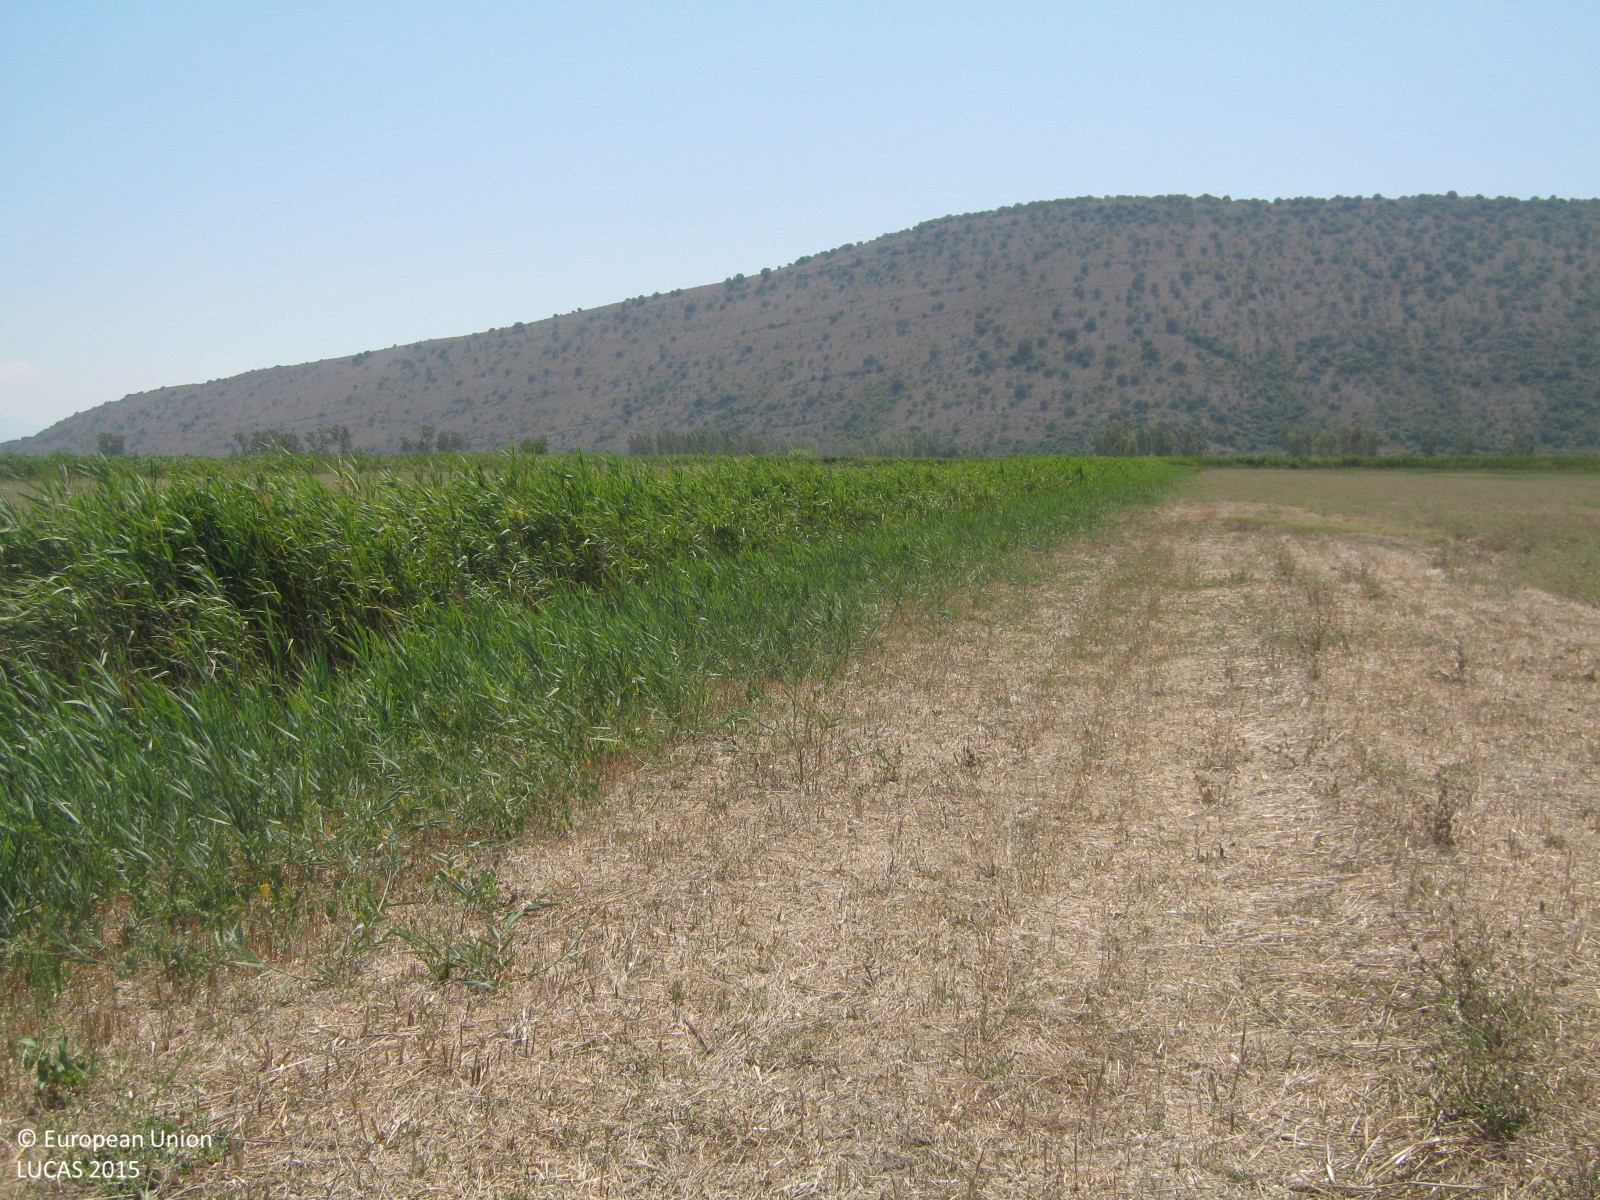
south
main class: Grassland
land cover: Spontaneously vegetated surfaces
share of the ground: > 75 %
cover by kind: herbaceous plants 100 %
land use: Fallow land
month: July
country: GR
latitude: 39.1157
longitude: 20.8558
